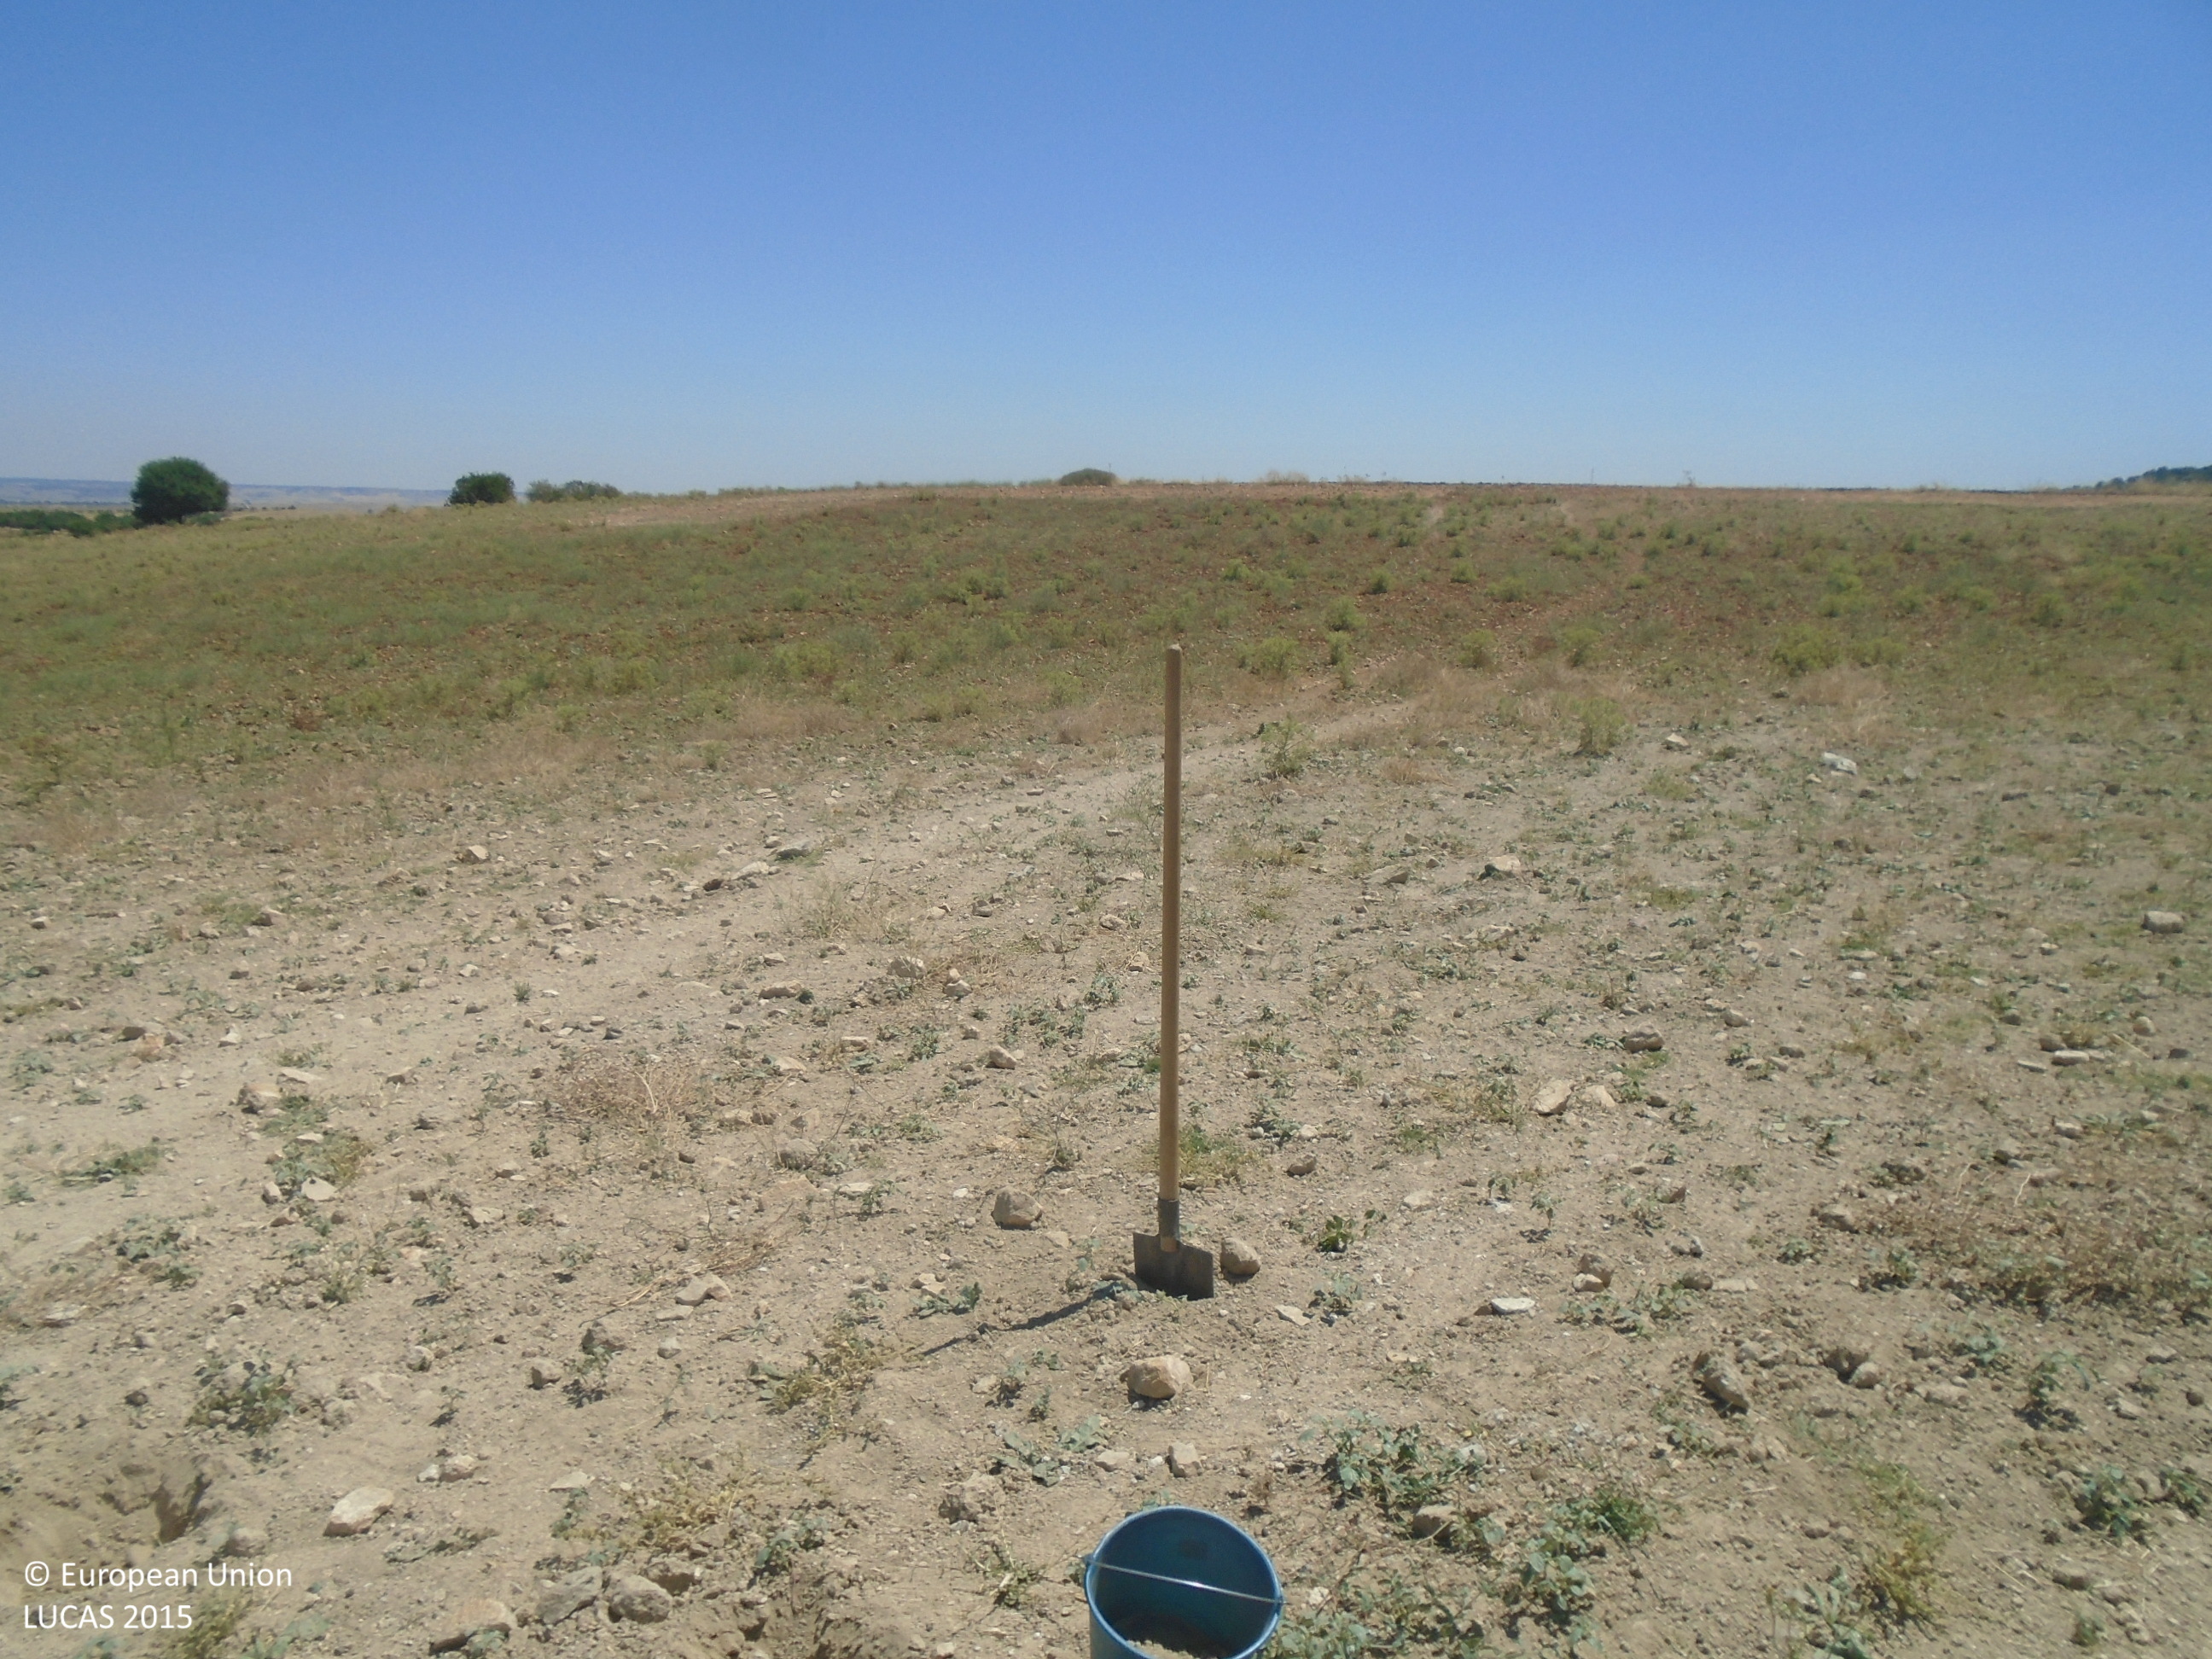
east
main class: Grassland
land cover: Spontaneously vegetated surfaces
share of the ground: > 75 %
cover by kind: herbaceous plants 90 %, unconsolidated bare surface 10 %
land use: Agriculture (excluding fallow land and kitchen gardens)
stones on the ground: < 10 %
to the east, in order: Spontaneously vegetated surfaces; Other bare soil; Spontaneously vegetated surfaces
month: July
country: ES
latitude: 39.7500
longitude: -4.9977
